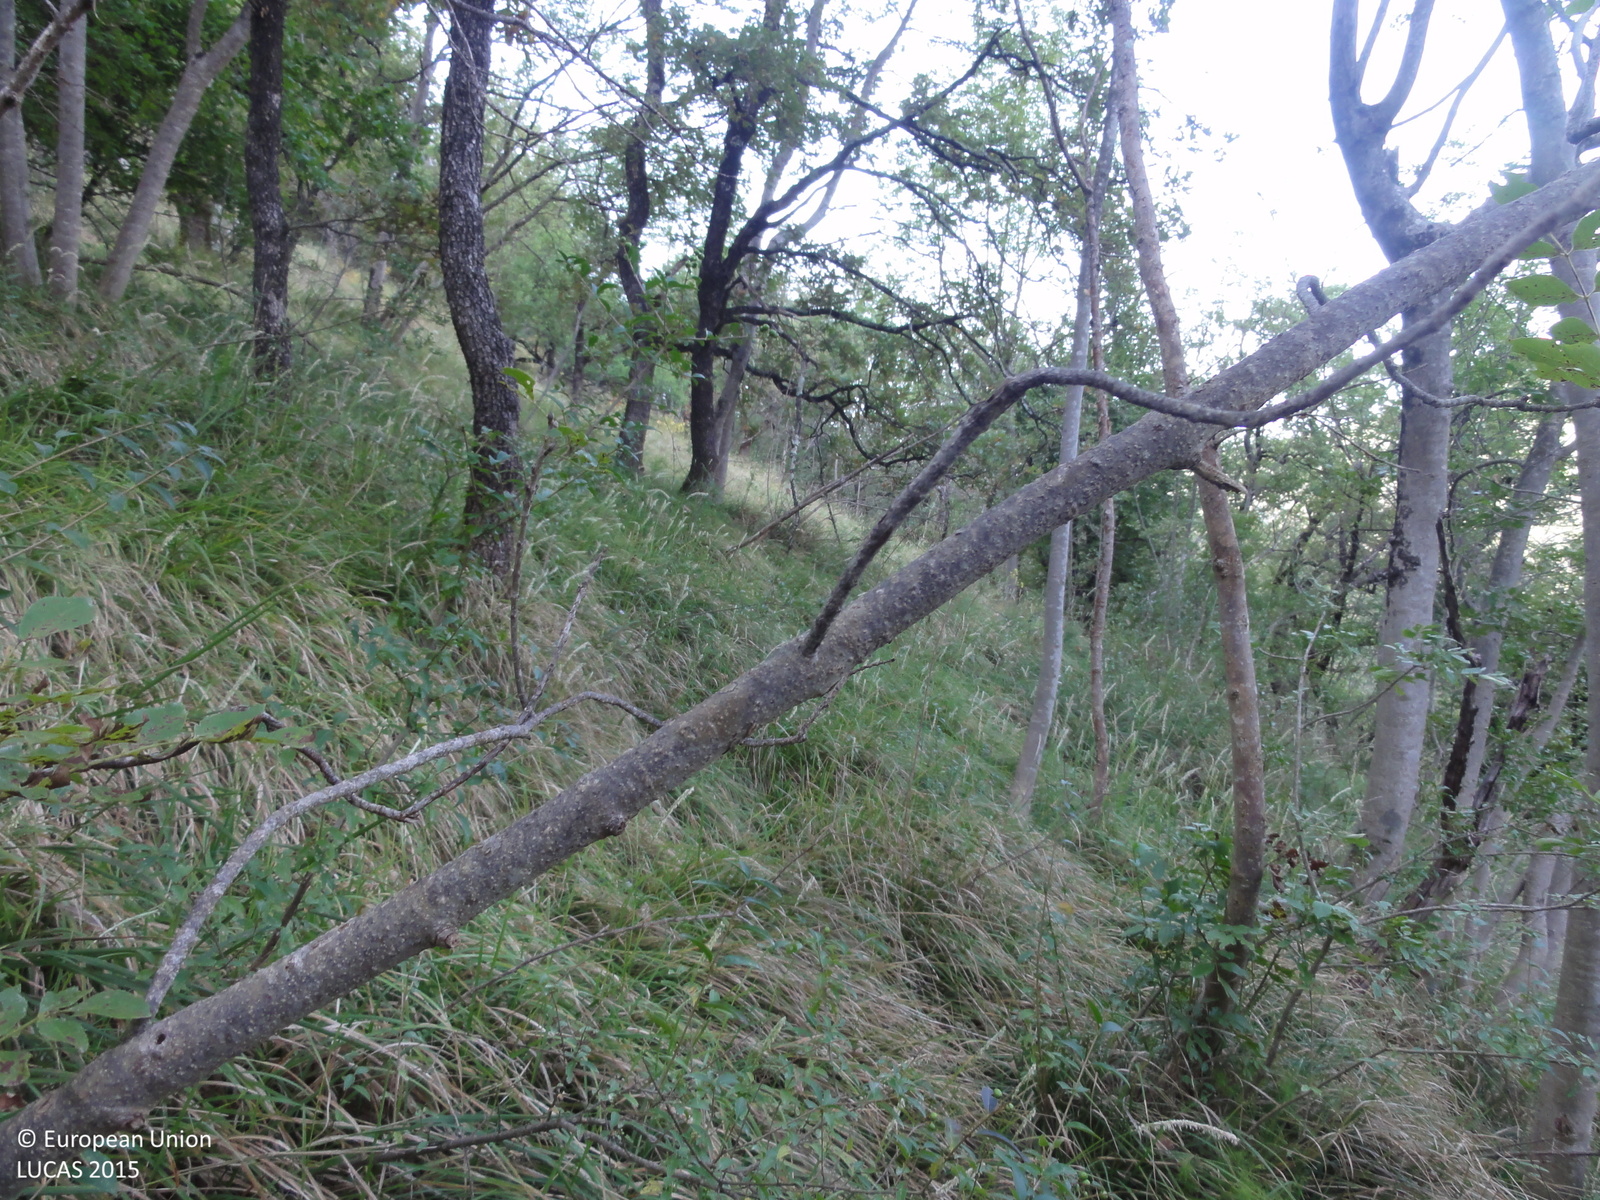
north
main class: Woodland
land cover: Broadleaved woodland
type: thermophilous deciduous forest
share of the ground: > 75 %
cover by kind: broadleaved forest trees 80 %, herbaceous plants 15 %, shrubs 5 %
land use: Semi-natural and natural areas not in use
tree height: > 5 m
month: August
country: SI
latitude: 46.0202
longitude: 13.6001
